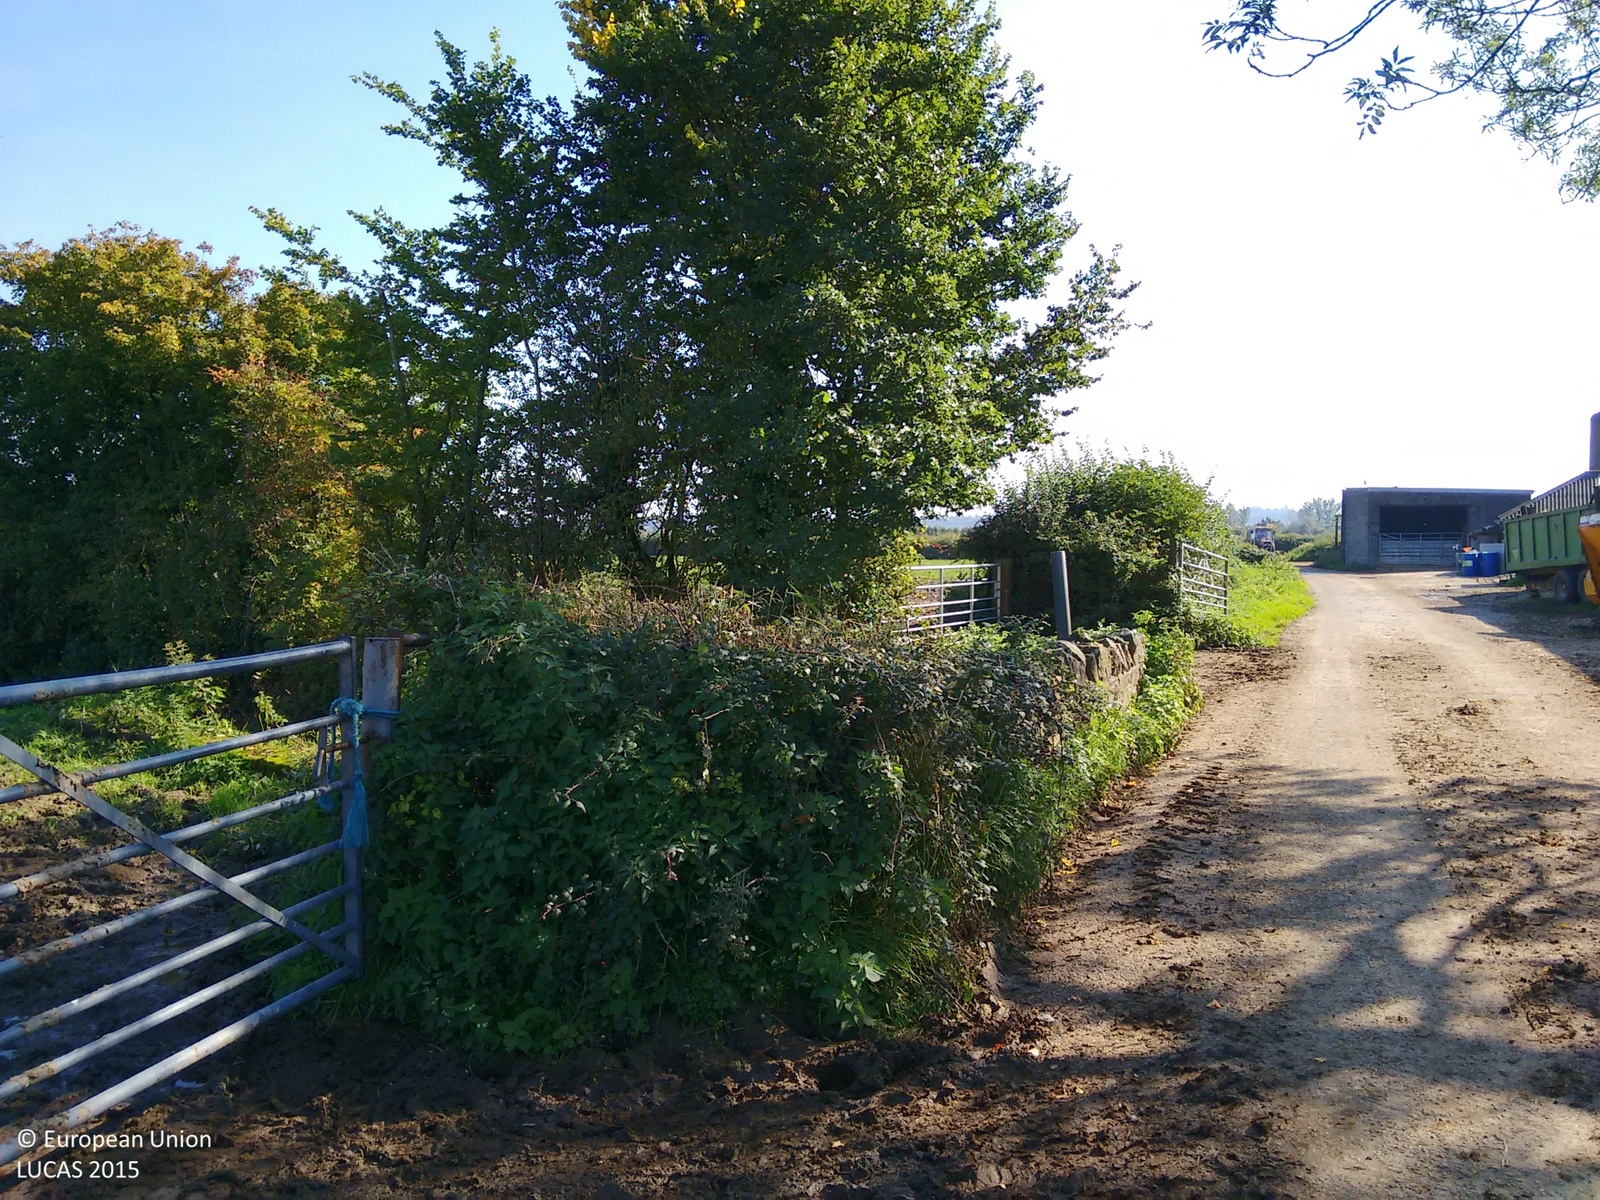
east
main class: Grassland
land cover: Grassland without tree/shrub cover
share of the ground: > 75 %
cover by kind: herbaceous plants 100 %
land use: Agriculture (excluding fallow land and kitchen gardens)
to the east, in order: Grassland without tree/shrub cover; Fences; Grassland without tree/shrub cover; Rivers and streams; Grass margins; Managed hedges; Grassland without tree/shrub cover; Managed hedges; Ditches and canals; Grassland without tree/shrub cover
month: September
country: GB
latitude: 51.5745
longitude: -2.6072
